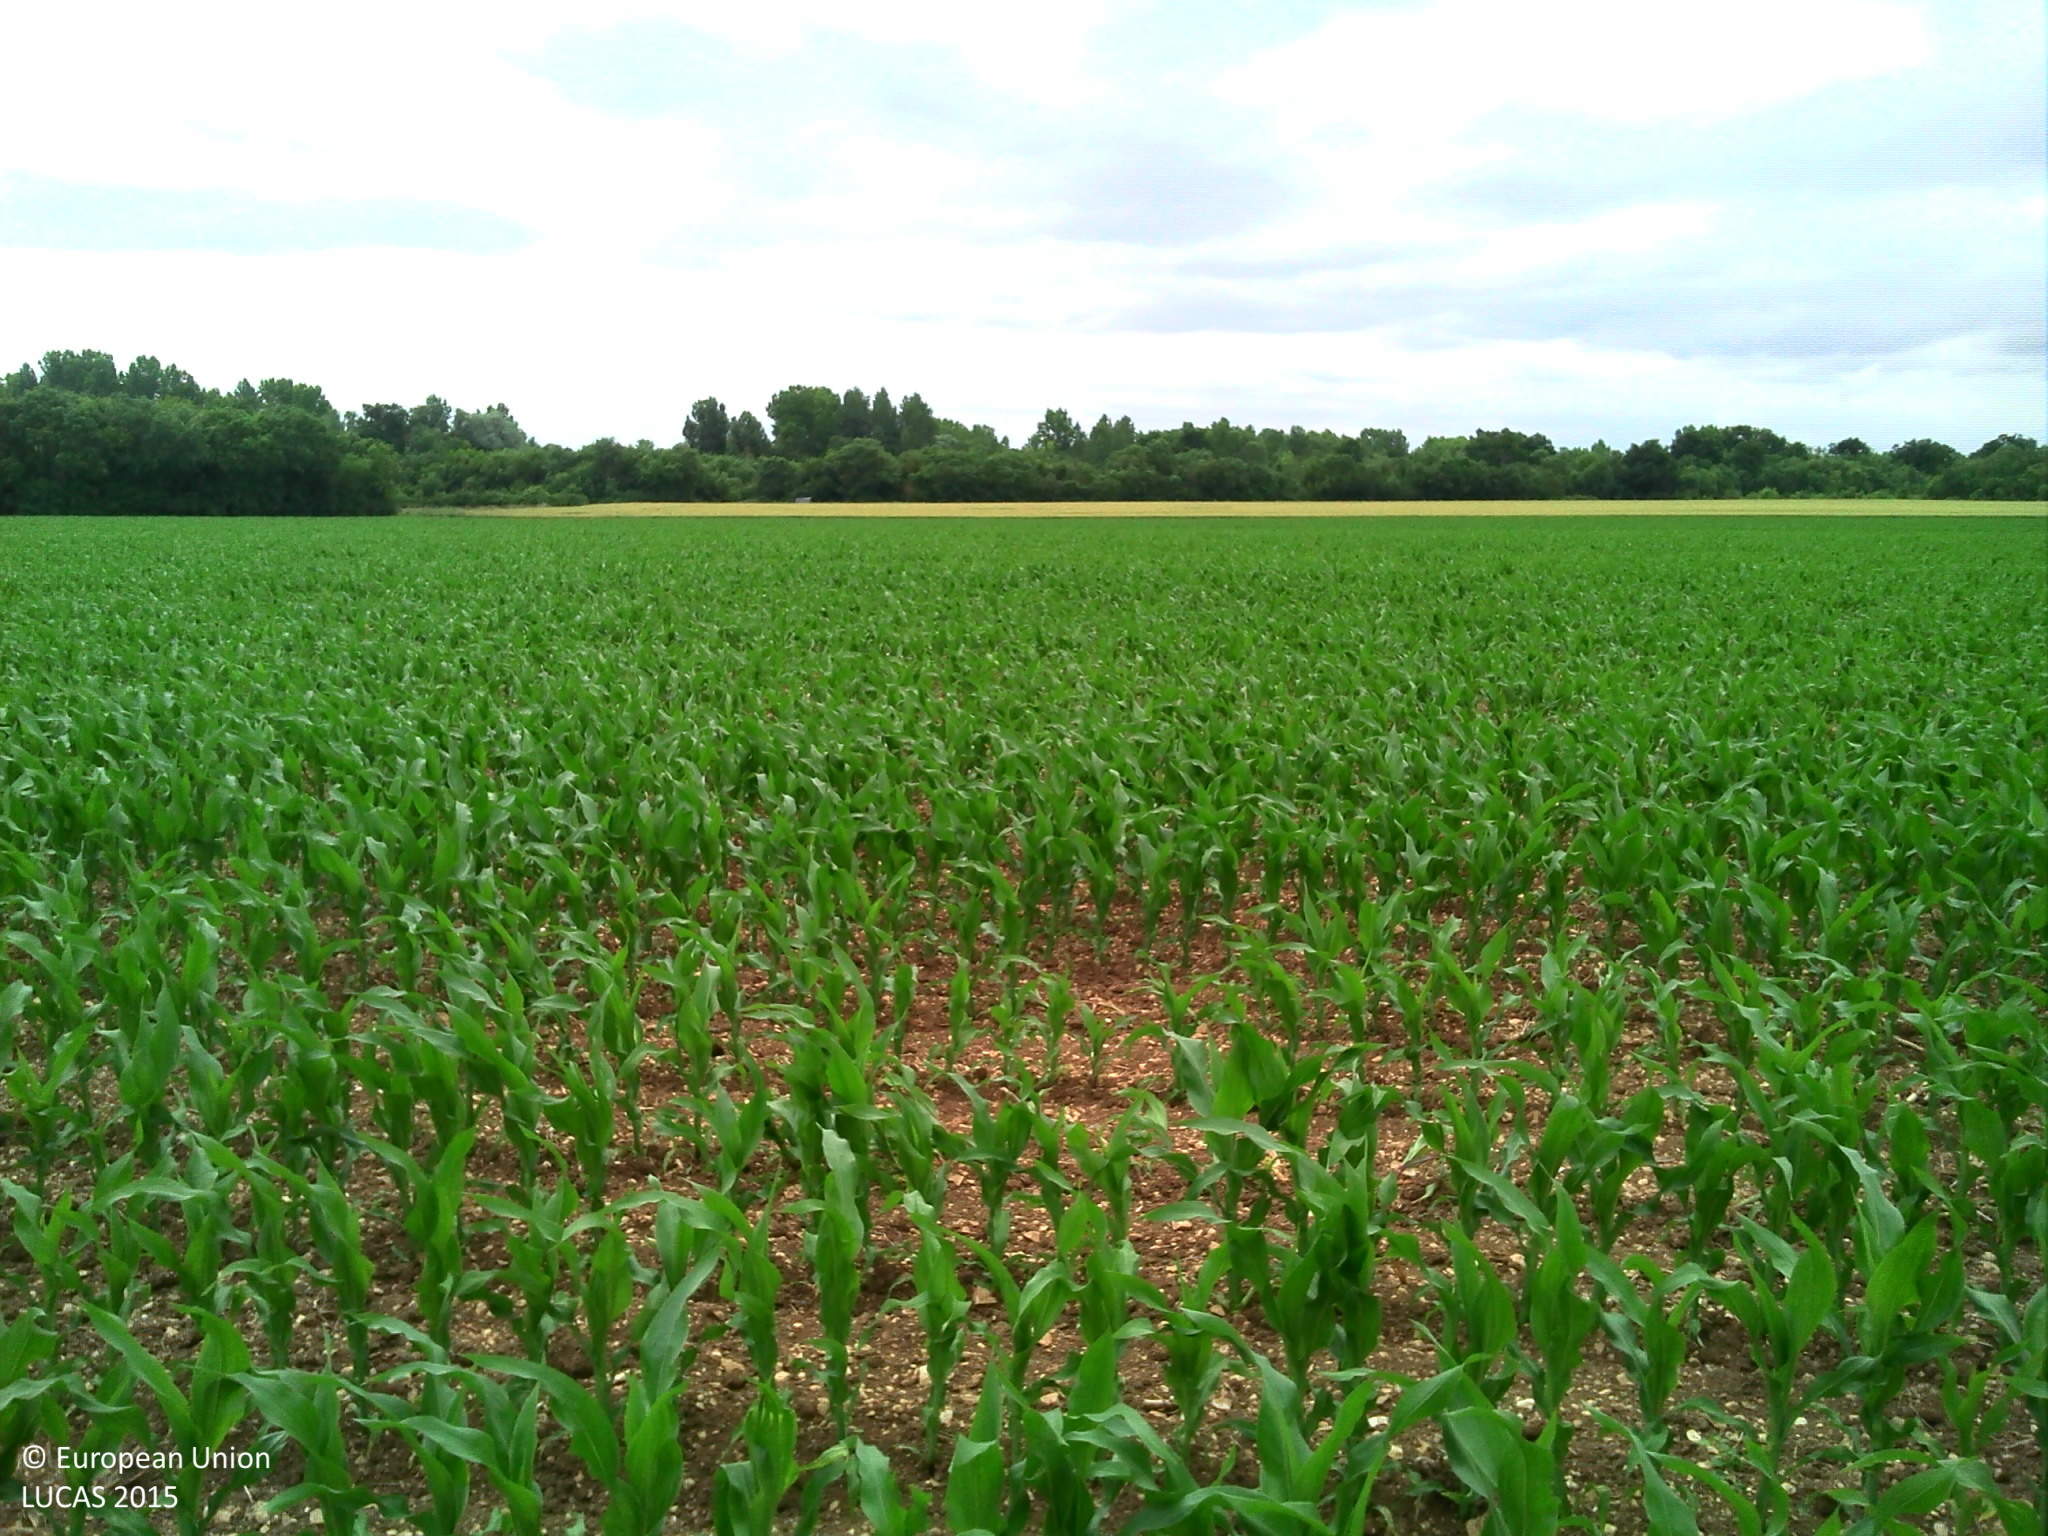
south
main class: Cropland
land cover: Maize
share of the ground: 50 - 75 %
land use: Agriculture (excluding fallow land and kitchen gardens)
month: June
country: FR
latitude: 46.2586
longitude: -0.7829
